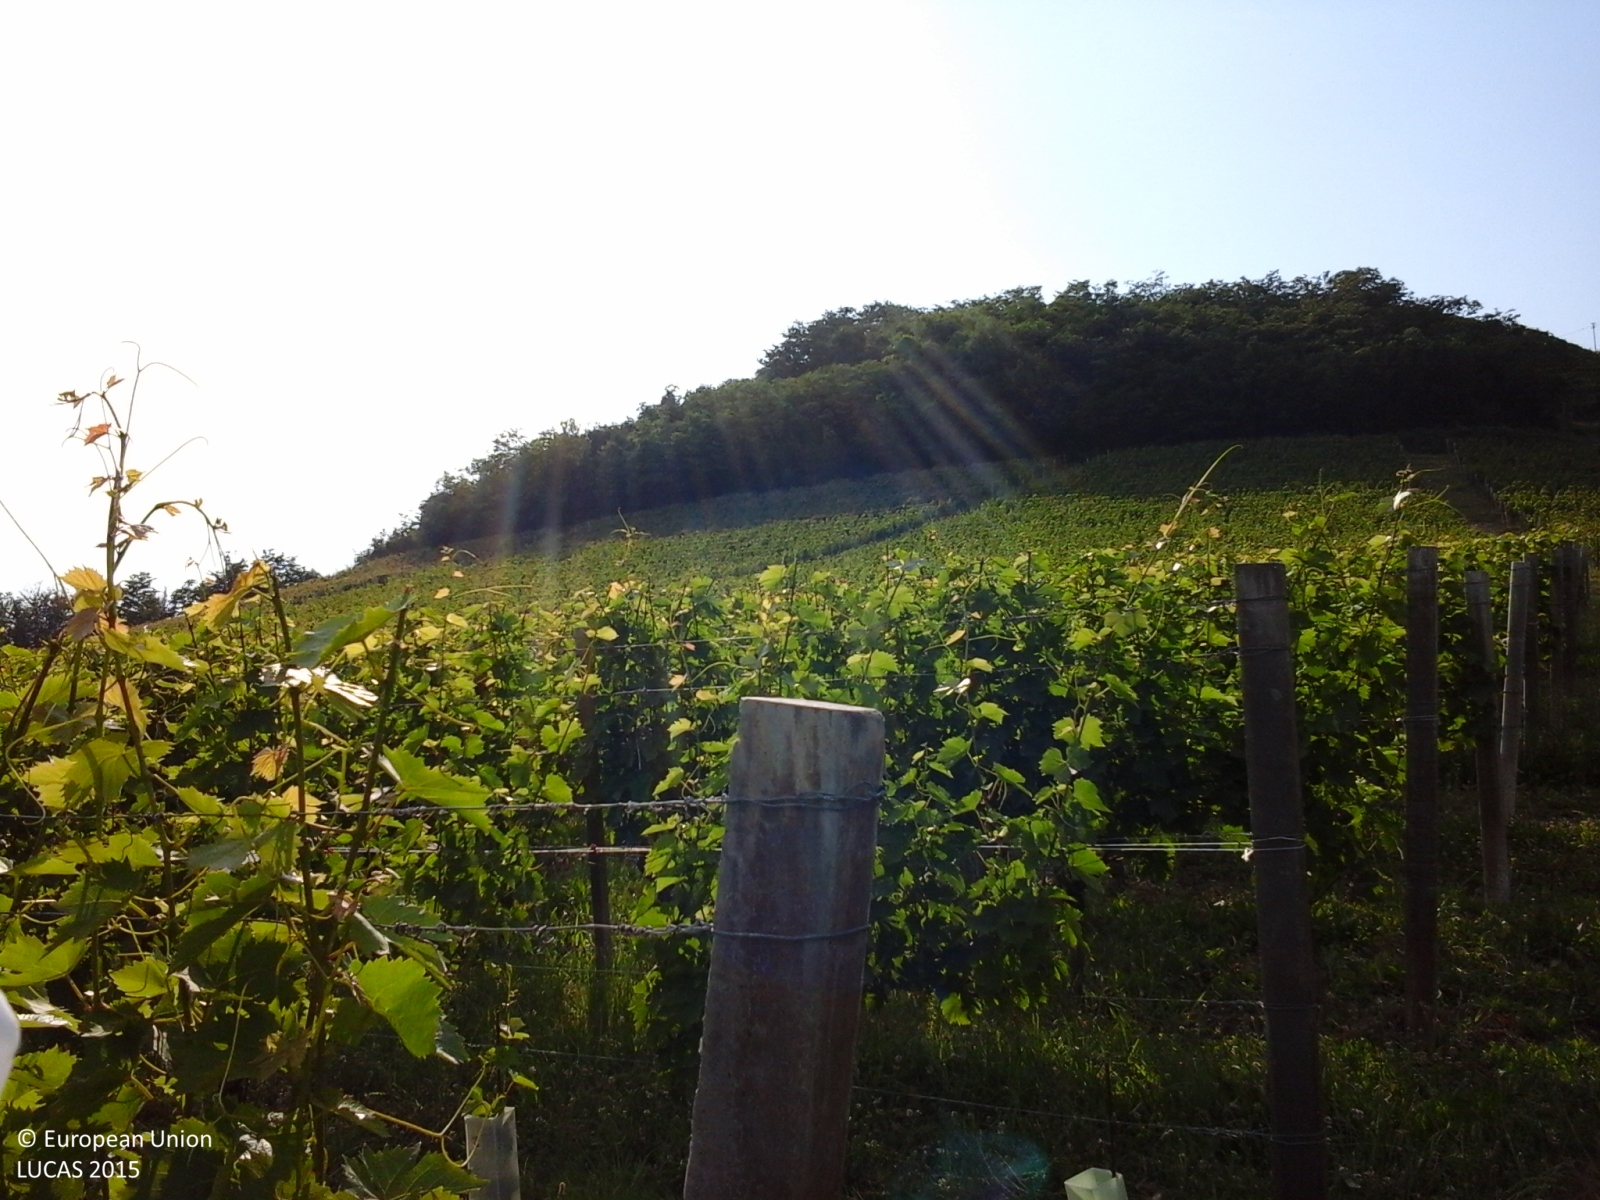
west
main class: Cropland
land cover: Vineyards
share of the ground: 50 - 75 %
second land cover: Grassland without tree/shrub cover
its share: > 75 %
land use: Agriculture (excluding fallow land and kitchen gardens)
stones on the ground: < 10 %
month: June
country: IT
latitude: 44.7146
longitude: 8.2489
